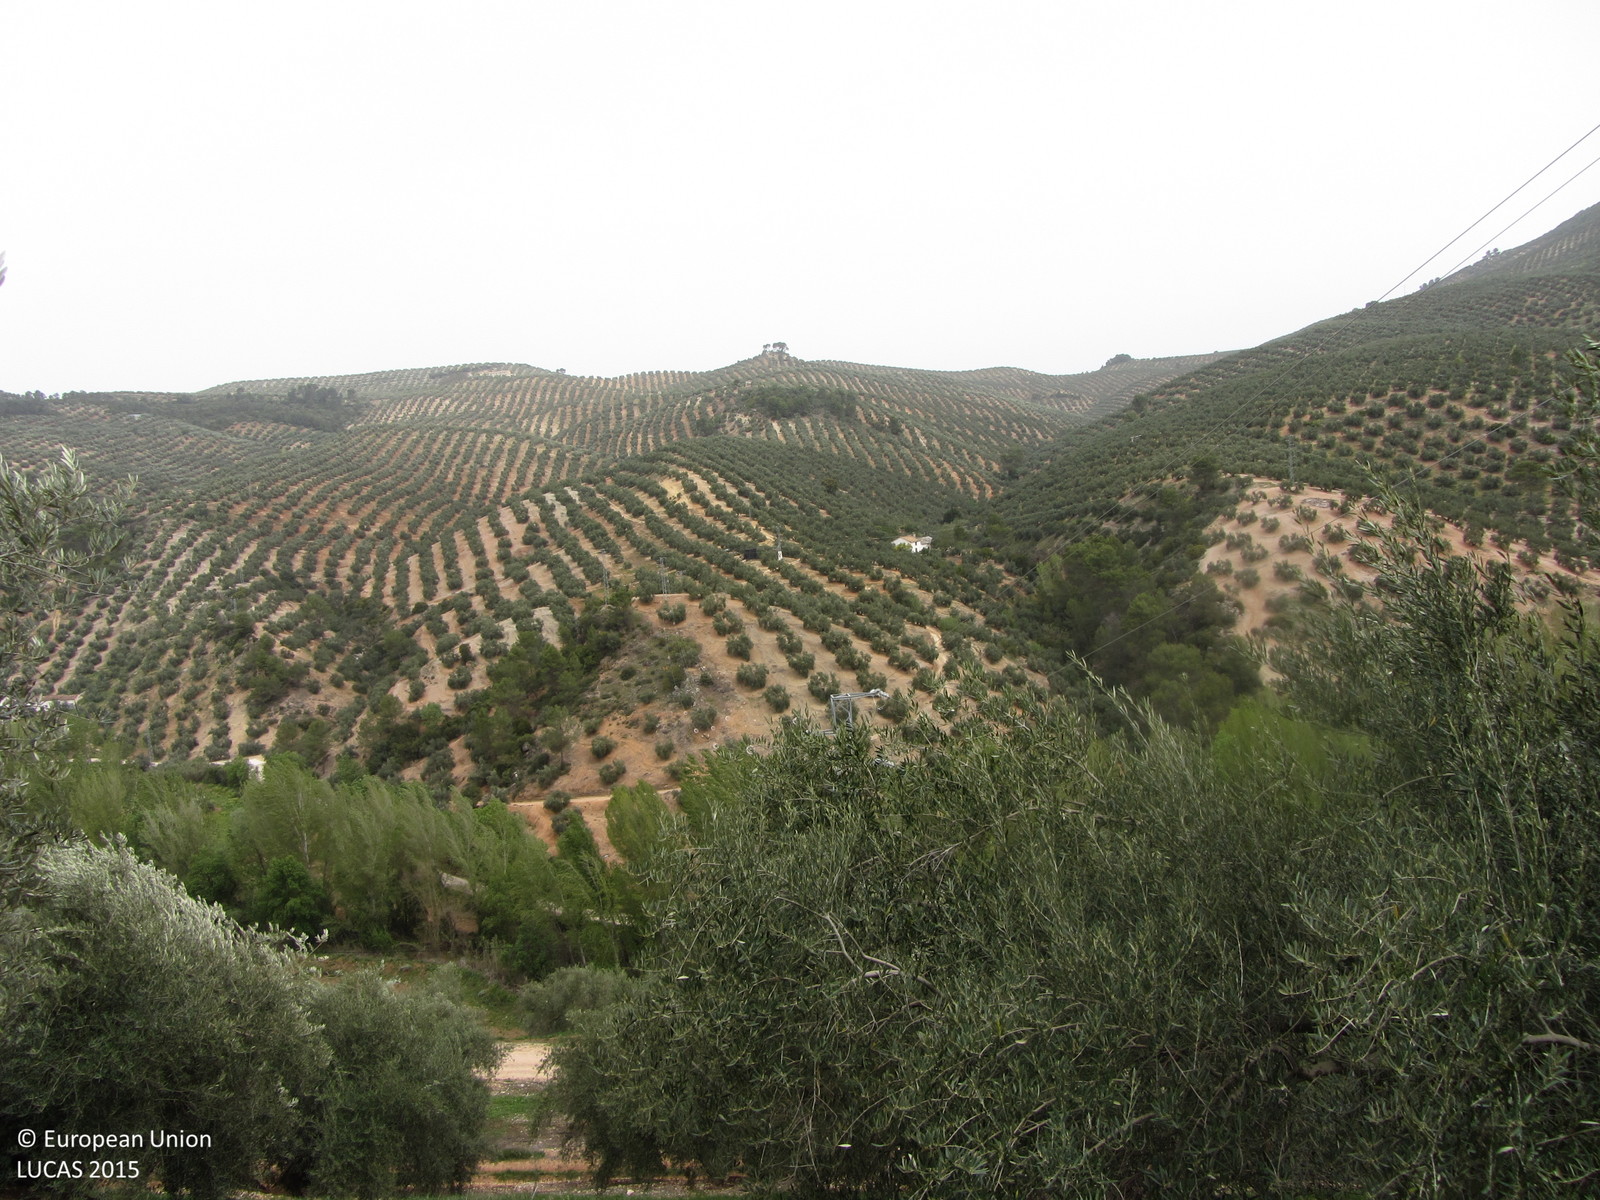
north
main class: Cropland
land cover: Olive groves
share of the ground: 50 - 75 %
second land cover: Spontaneously vegetated surfaces
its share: 10 - 25 %
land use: Agriculture (excluding fallow land and kitchen gardens)
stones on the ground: > 50 %
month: April
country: ES
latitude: 38.0820
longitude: -2.9828
